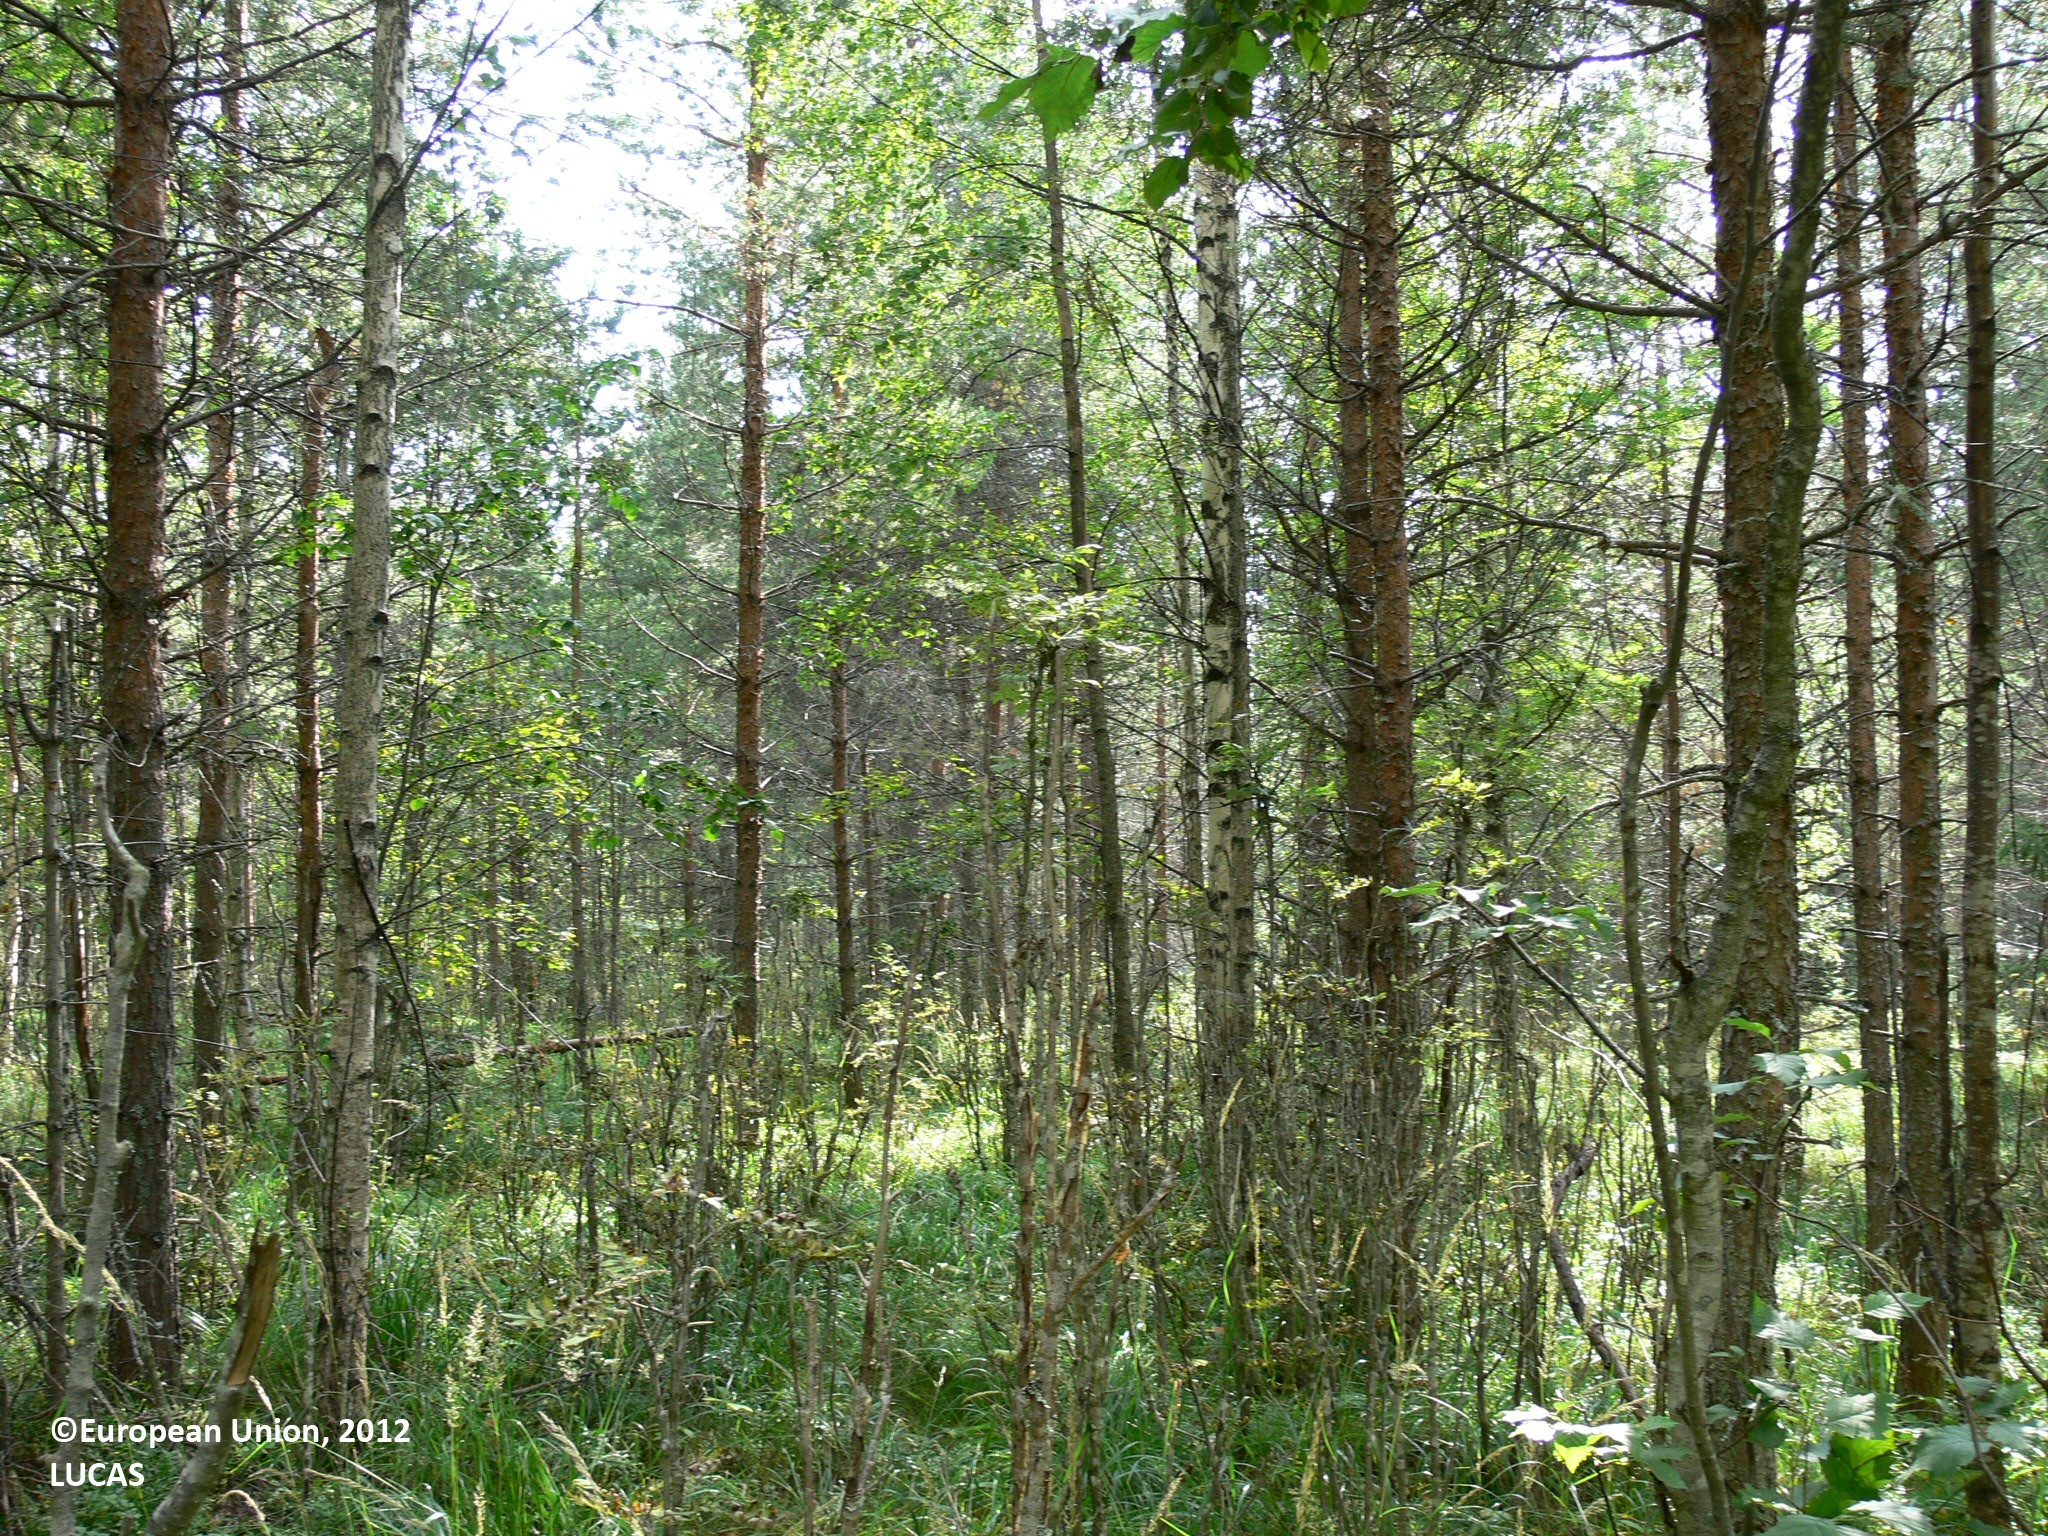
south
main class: Woodland
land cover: Other mixed woodland
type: boreal forest
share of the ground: > 75 %
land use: Amenities, museums, leisure
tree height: > 5 m
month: August
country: FI
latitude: 63.0149
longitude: 29.9463
